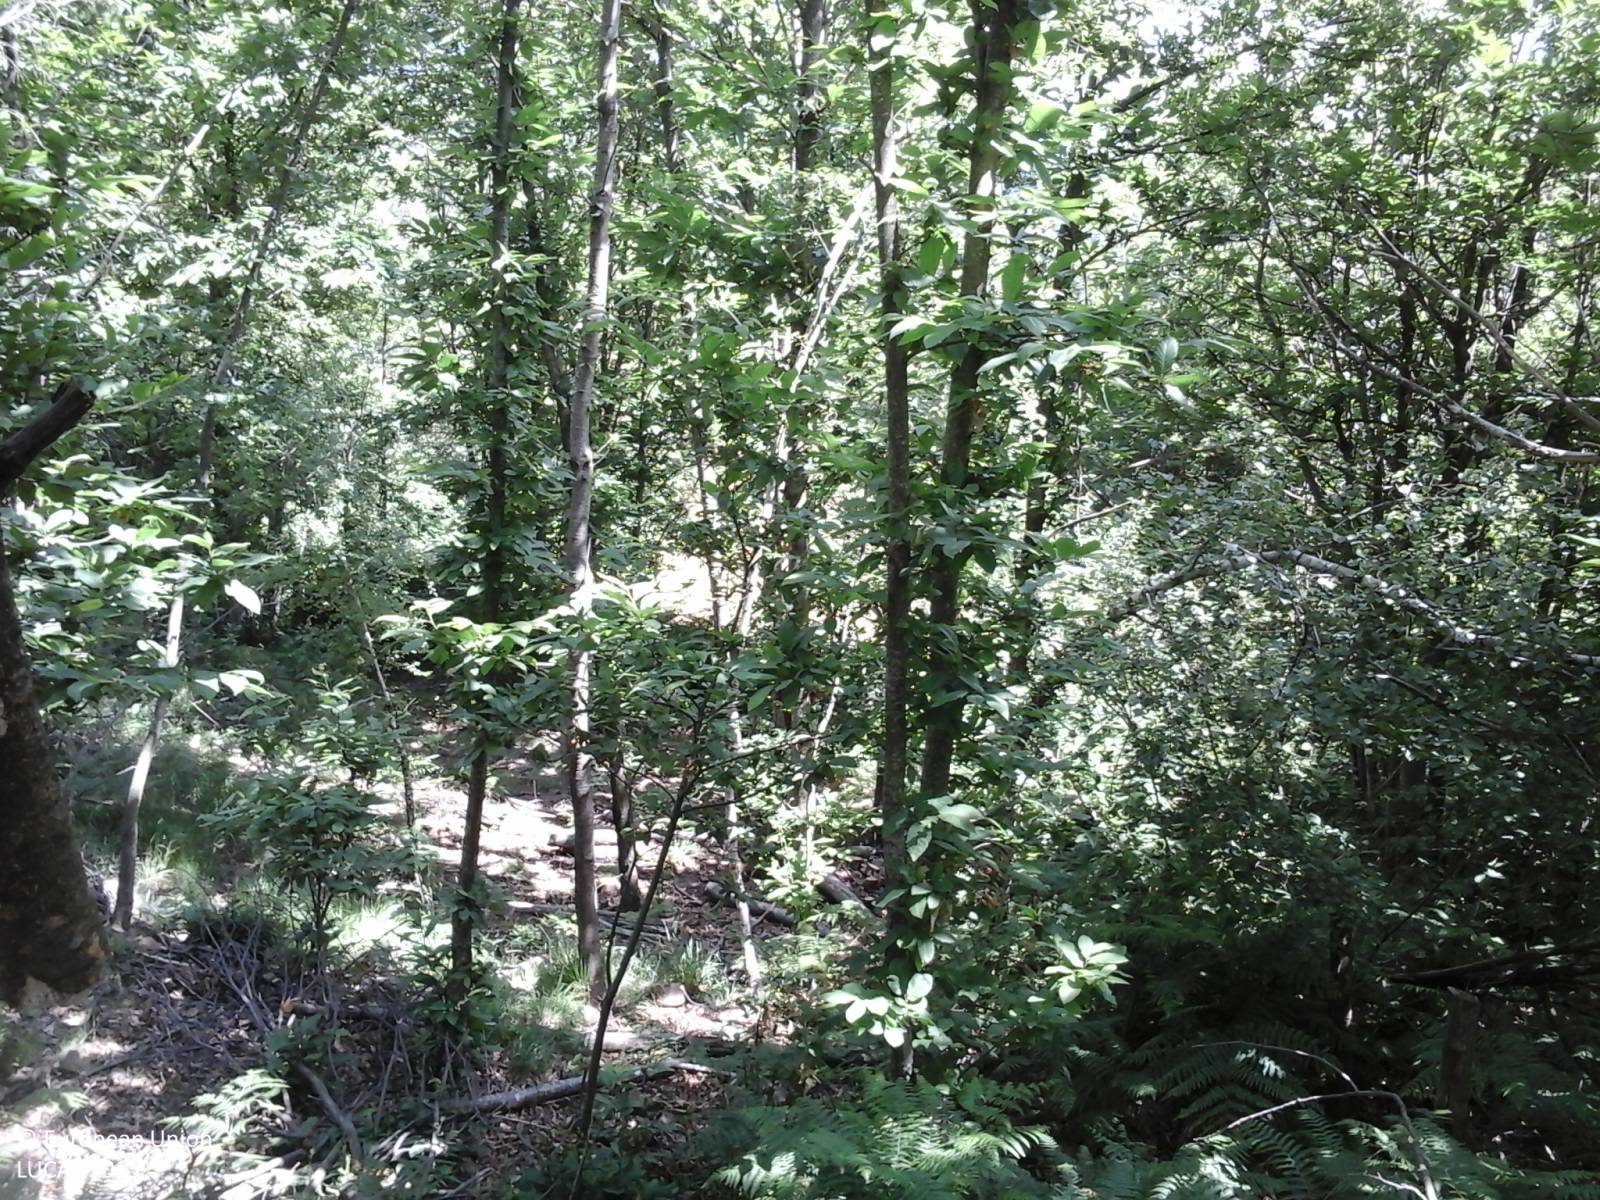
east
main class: Woodland
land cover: Broadleaved woodland
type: thermophilous deciduous forest
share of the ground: > 75 %
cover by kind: broadleaved forest trees 100 %
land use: Forestry
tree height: > 5 m
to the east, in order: Broadleaved woodland
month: June
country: IT
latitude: 44.1877
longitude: 10.3370
